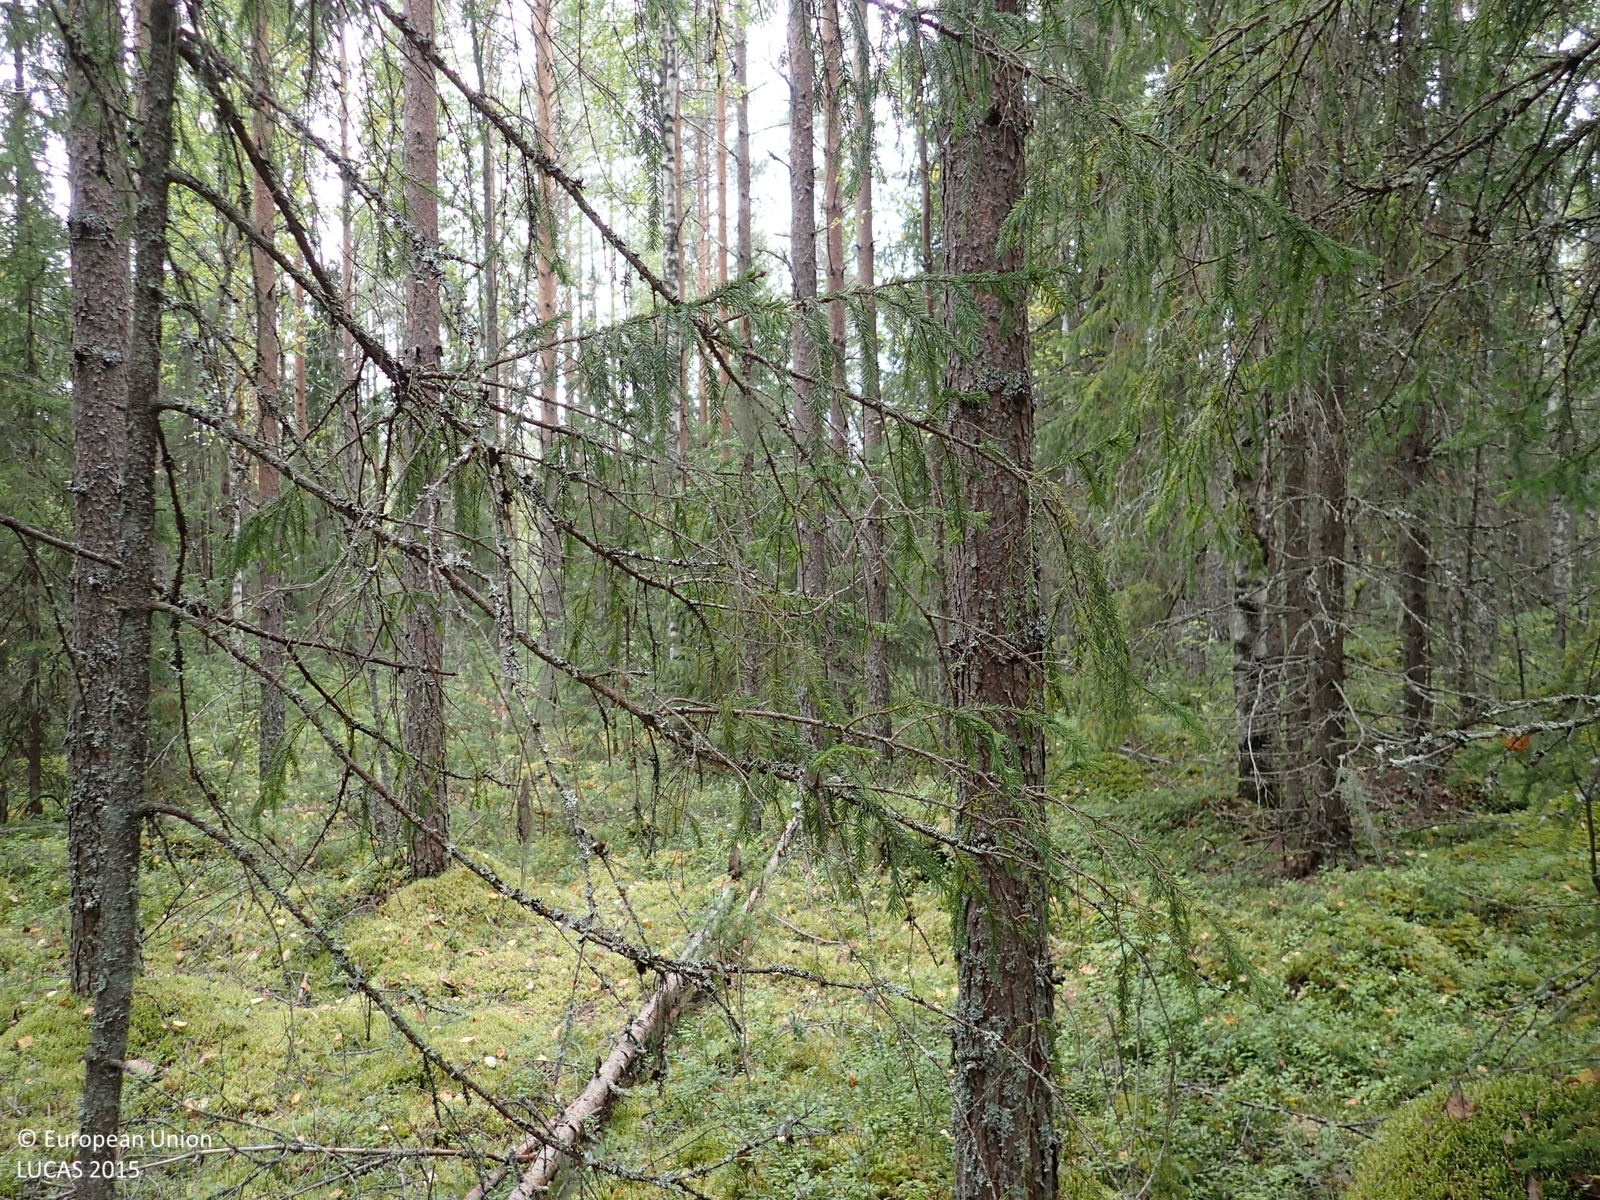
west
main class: Woodland
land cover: Other coniferous woodland
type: boreal forest
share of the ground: > 75 %
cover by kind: coniferous forest trees 70 %, broadleaved forest trees 10 %, shrubs 10 %, lichens and mosses 10 %
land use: Forestry
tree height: > 5 m
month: September
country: FI
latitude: 62.9616
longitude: 25.7089
